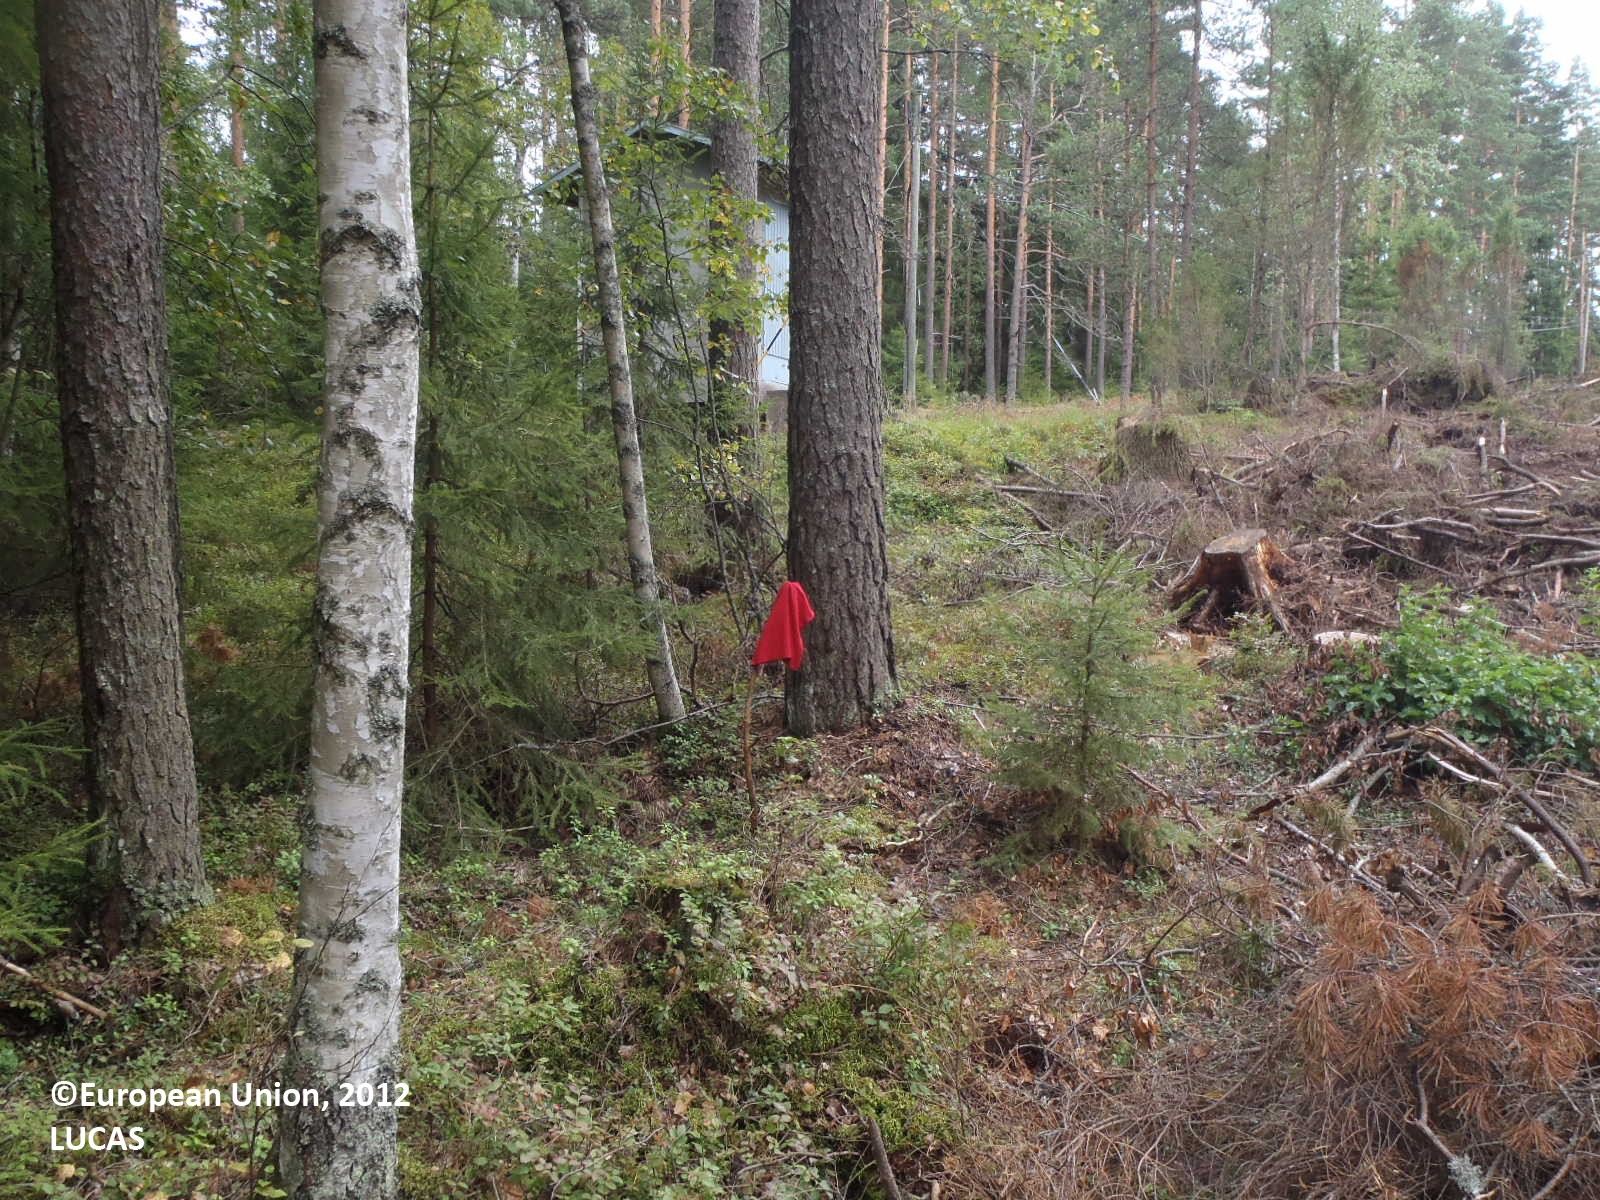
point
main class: Woodland
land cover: Pine dominated mixed woodland
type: boreal forest
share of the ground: > 75 %
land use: Forestry
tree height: > 5 m
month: August
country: FI
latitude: 60.8863
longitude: 22.2430
